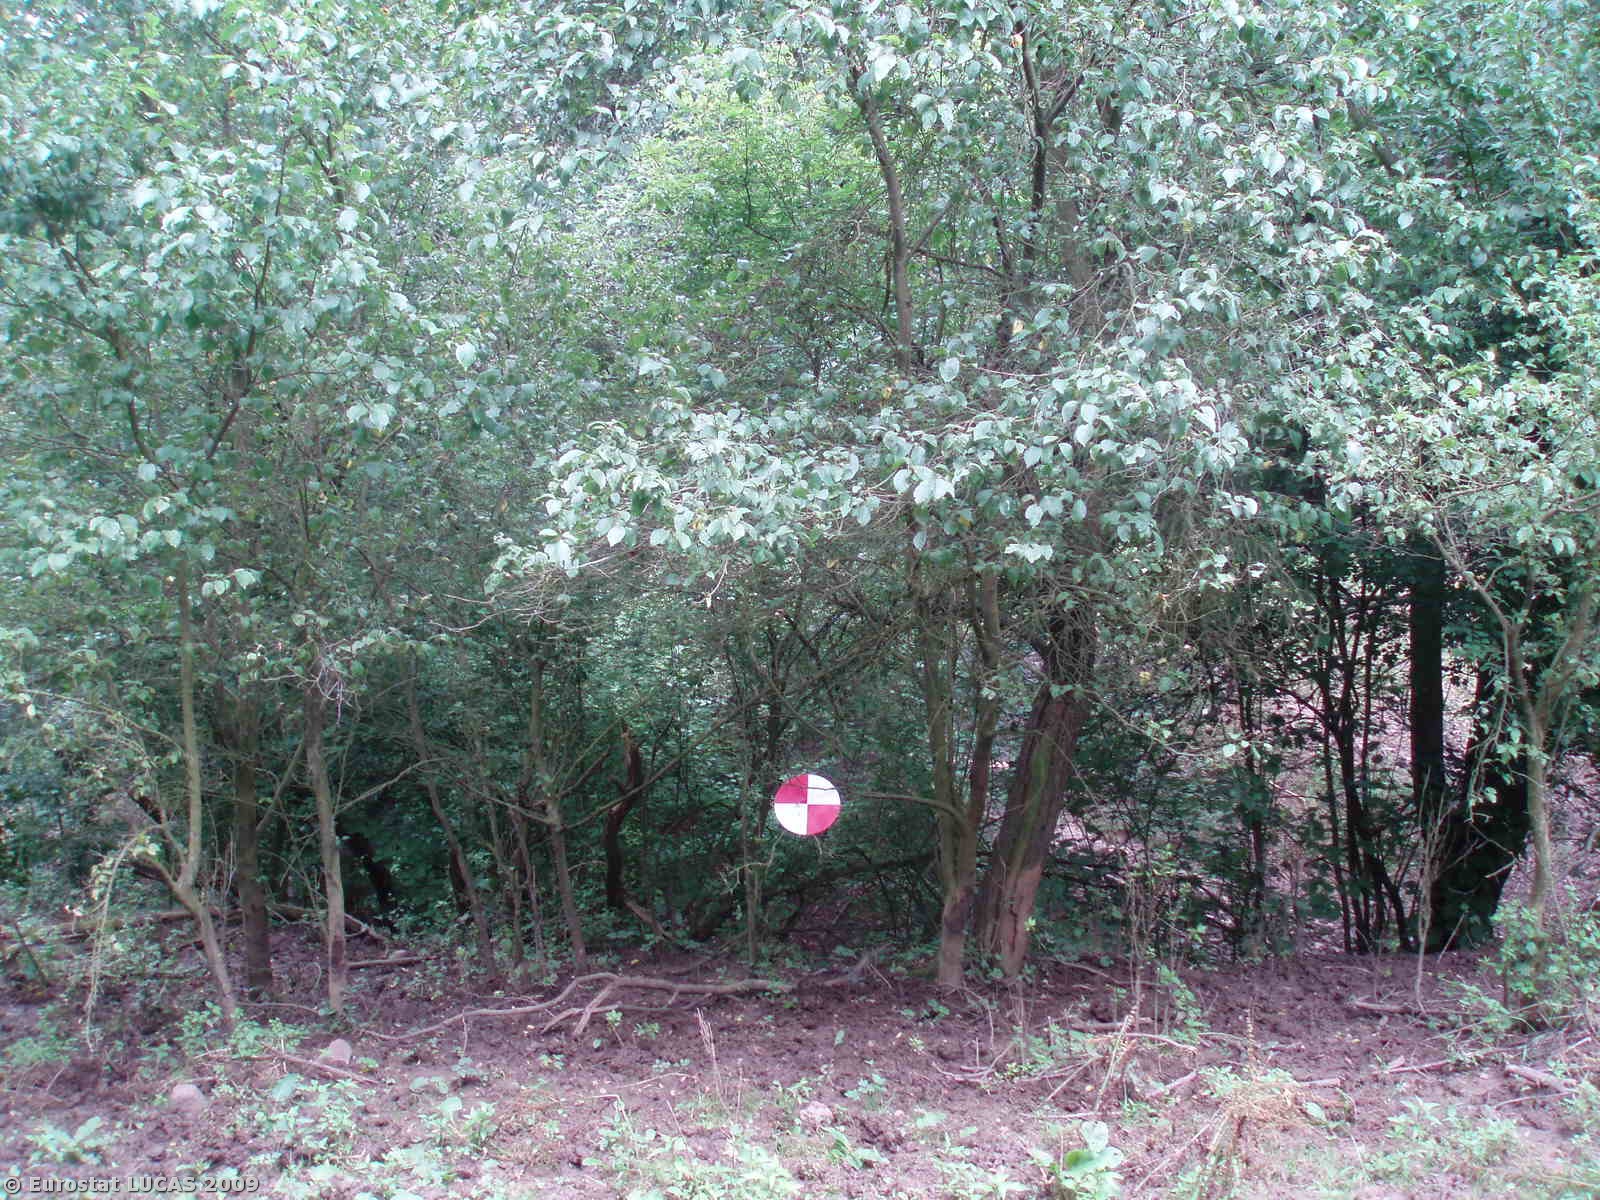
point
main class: Woodland
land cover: Broadleaved woodland
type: mesophytic deciduous forest
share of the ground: > 75 %
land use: Forestry
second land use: Nature reserves
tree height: > 5 m
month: July
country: CZ
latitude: 50.7009
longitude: 14.2064
